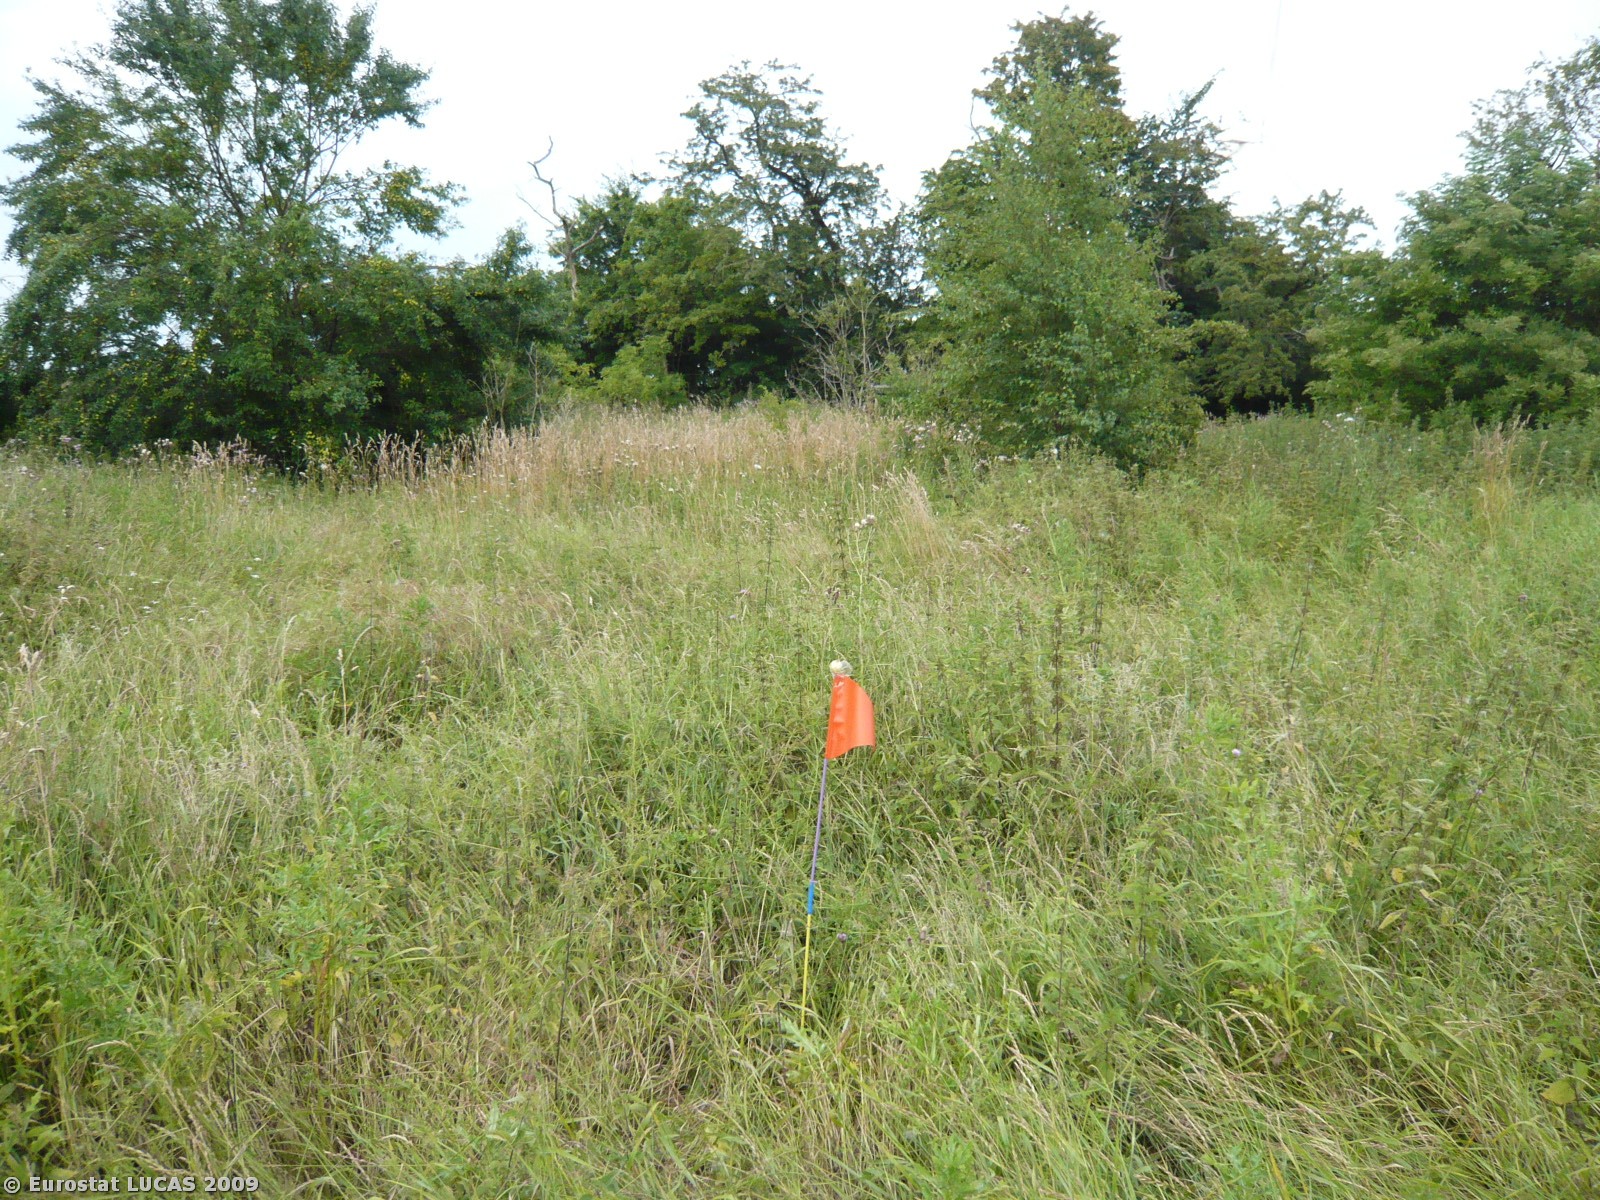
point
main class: Grassland
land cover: Spontaneously vegetated surfaces
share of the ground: > 75 %
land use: Residential
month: July
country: DK
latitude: 55.8994
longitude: 12.1890
